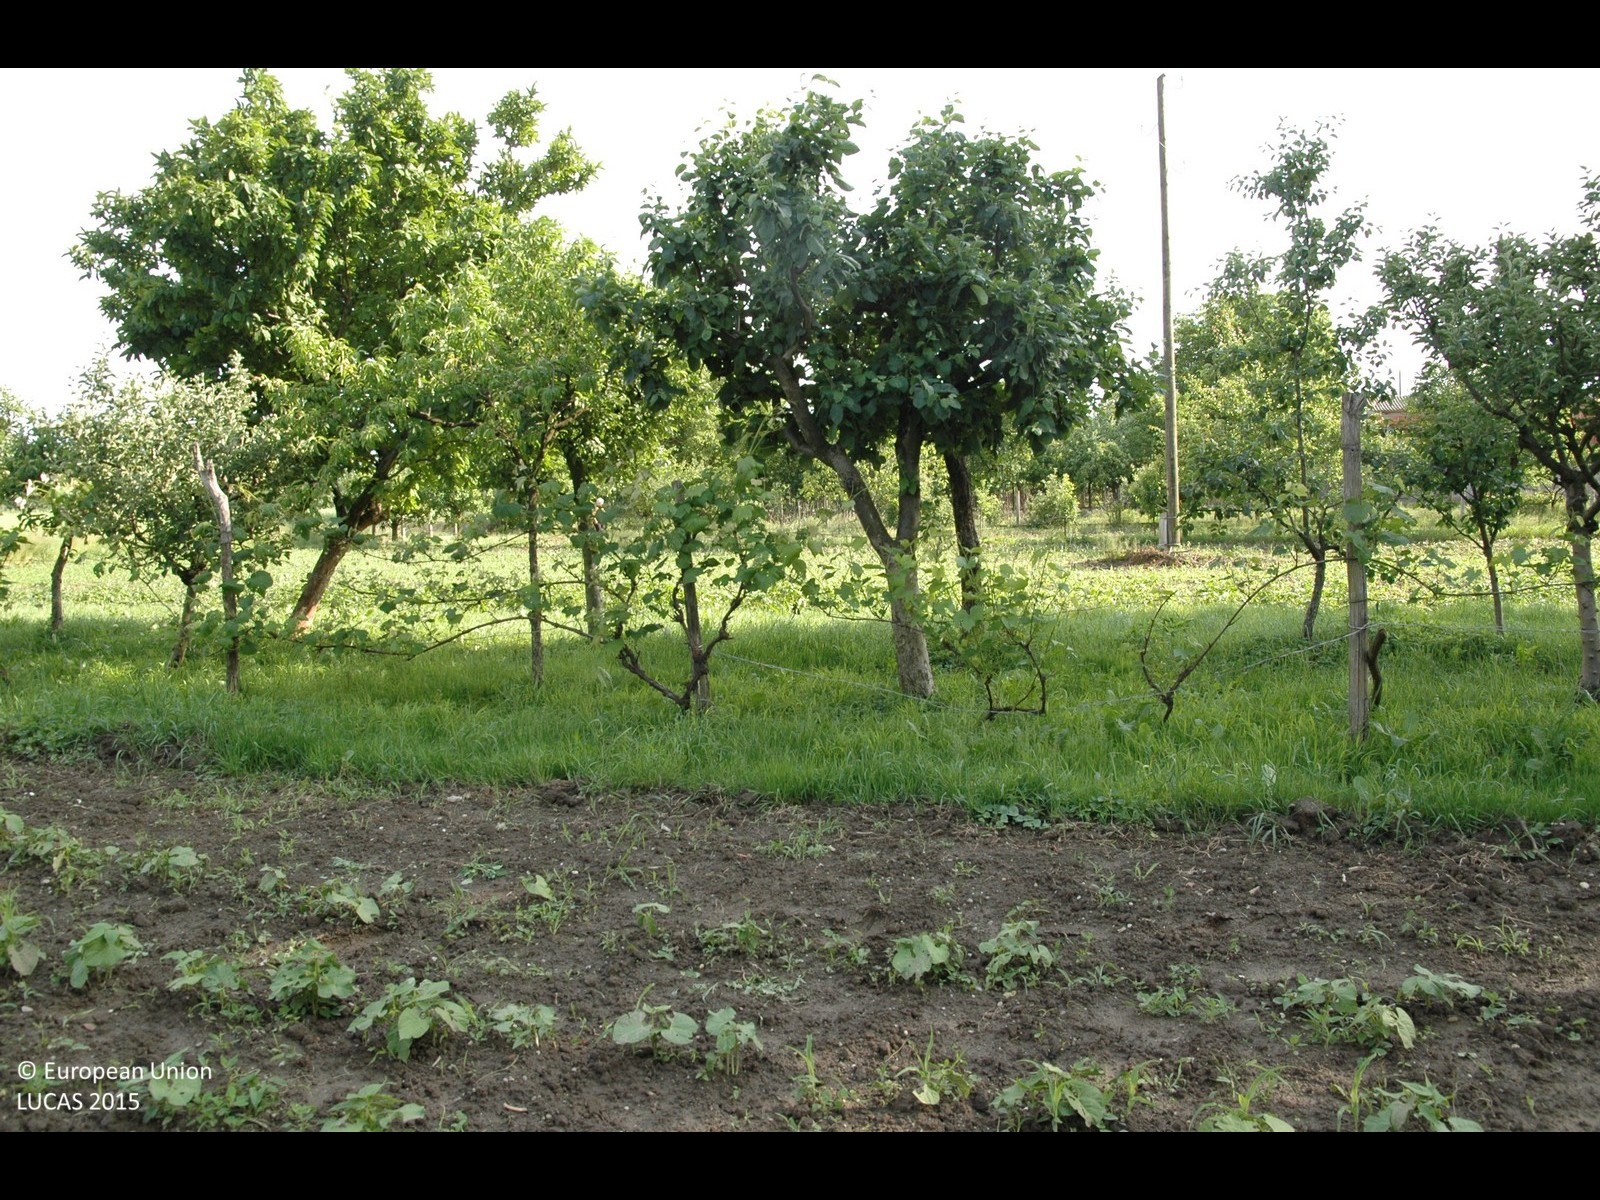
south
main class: Cropland
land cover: Dry pulses
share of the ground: > 75 %
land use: Kitchen garden
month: May
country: HR
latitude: 46.3142
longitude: 16.8194
